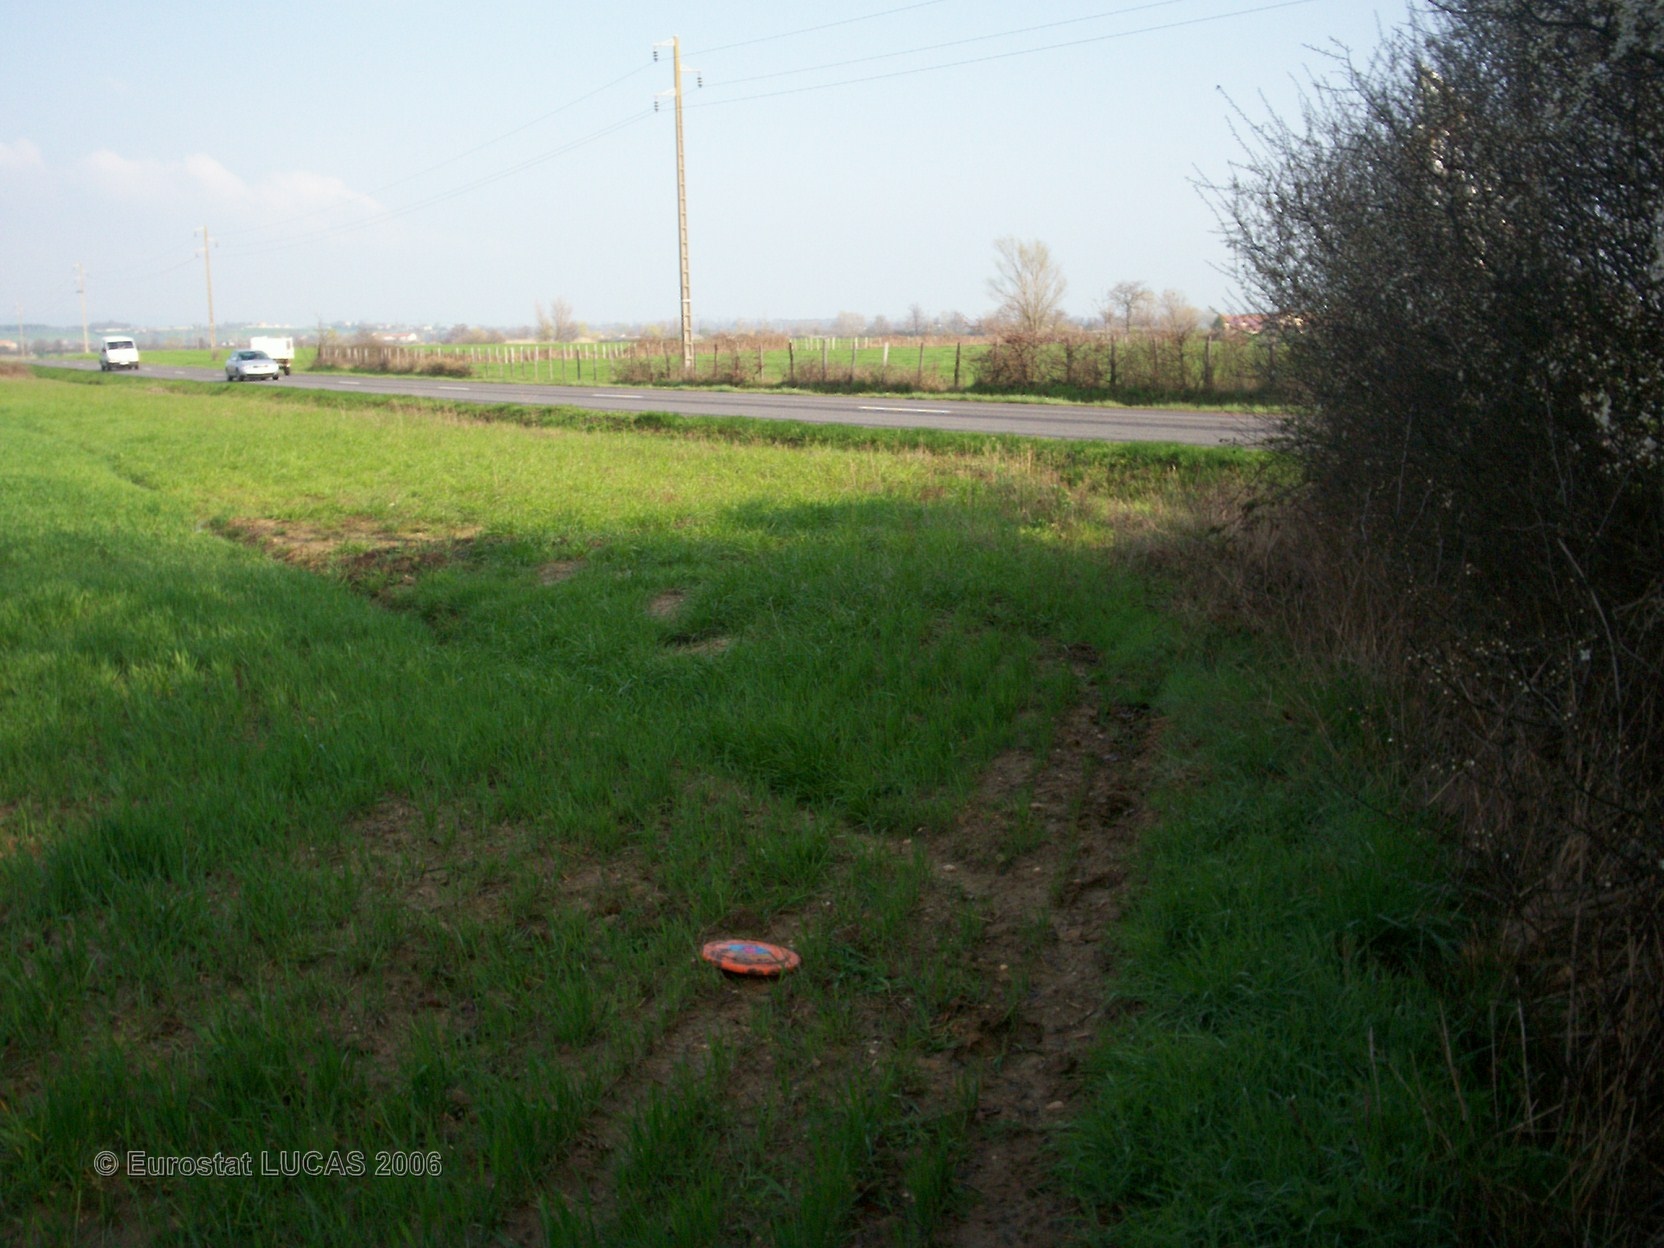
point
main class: Woodland
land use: Unused
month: April
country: FR
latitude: 45.5589
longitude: 4.1484
